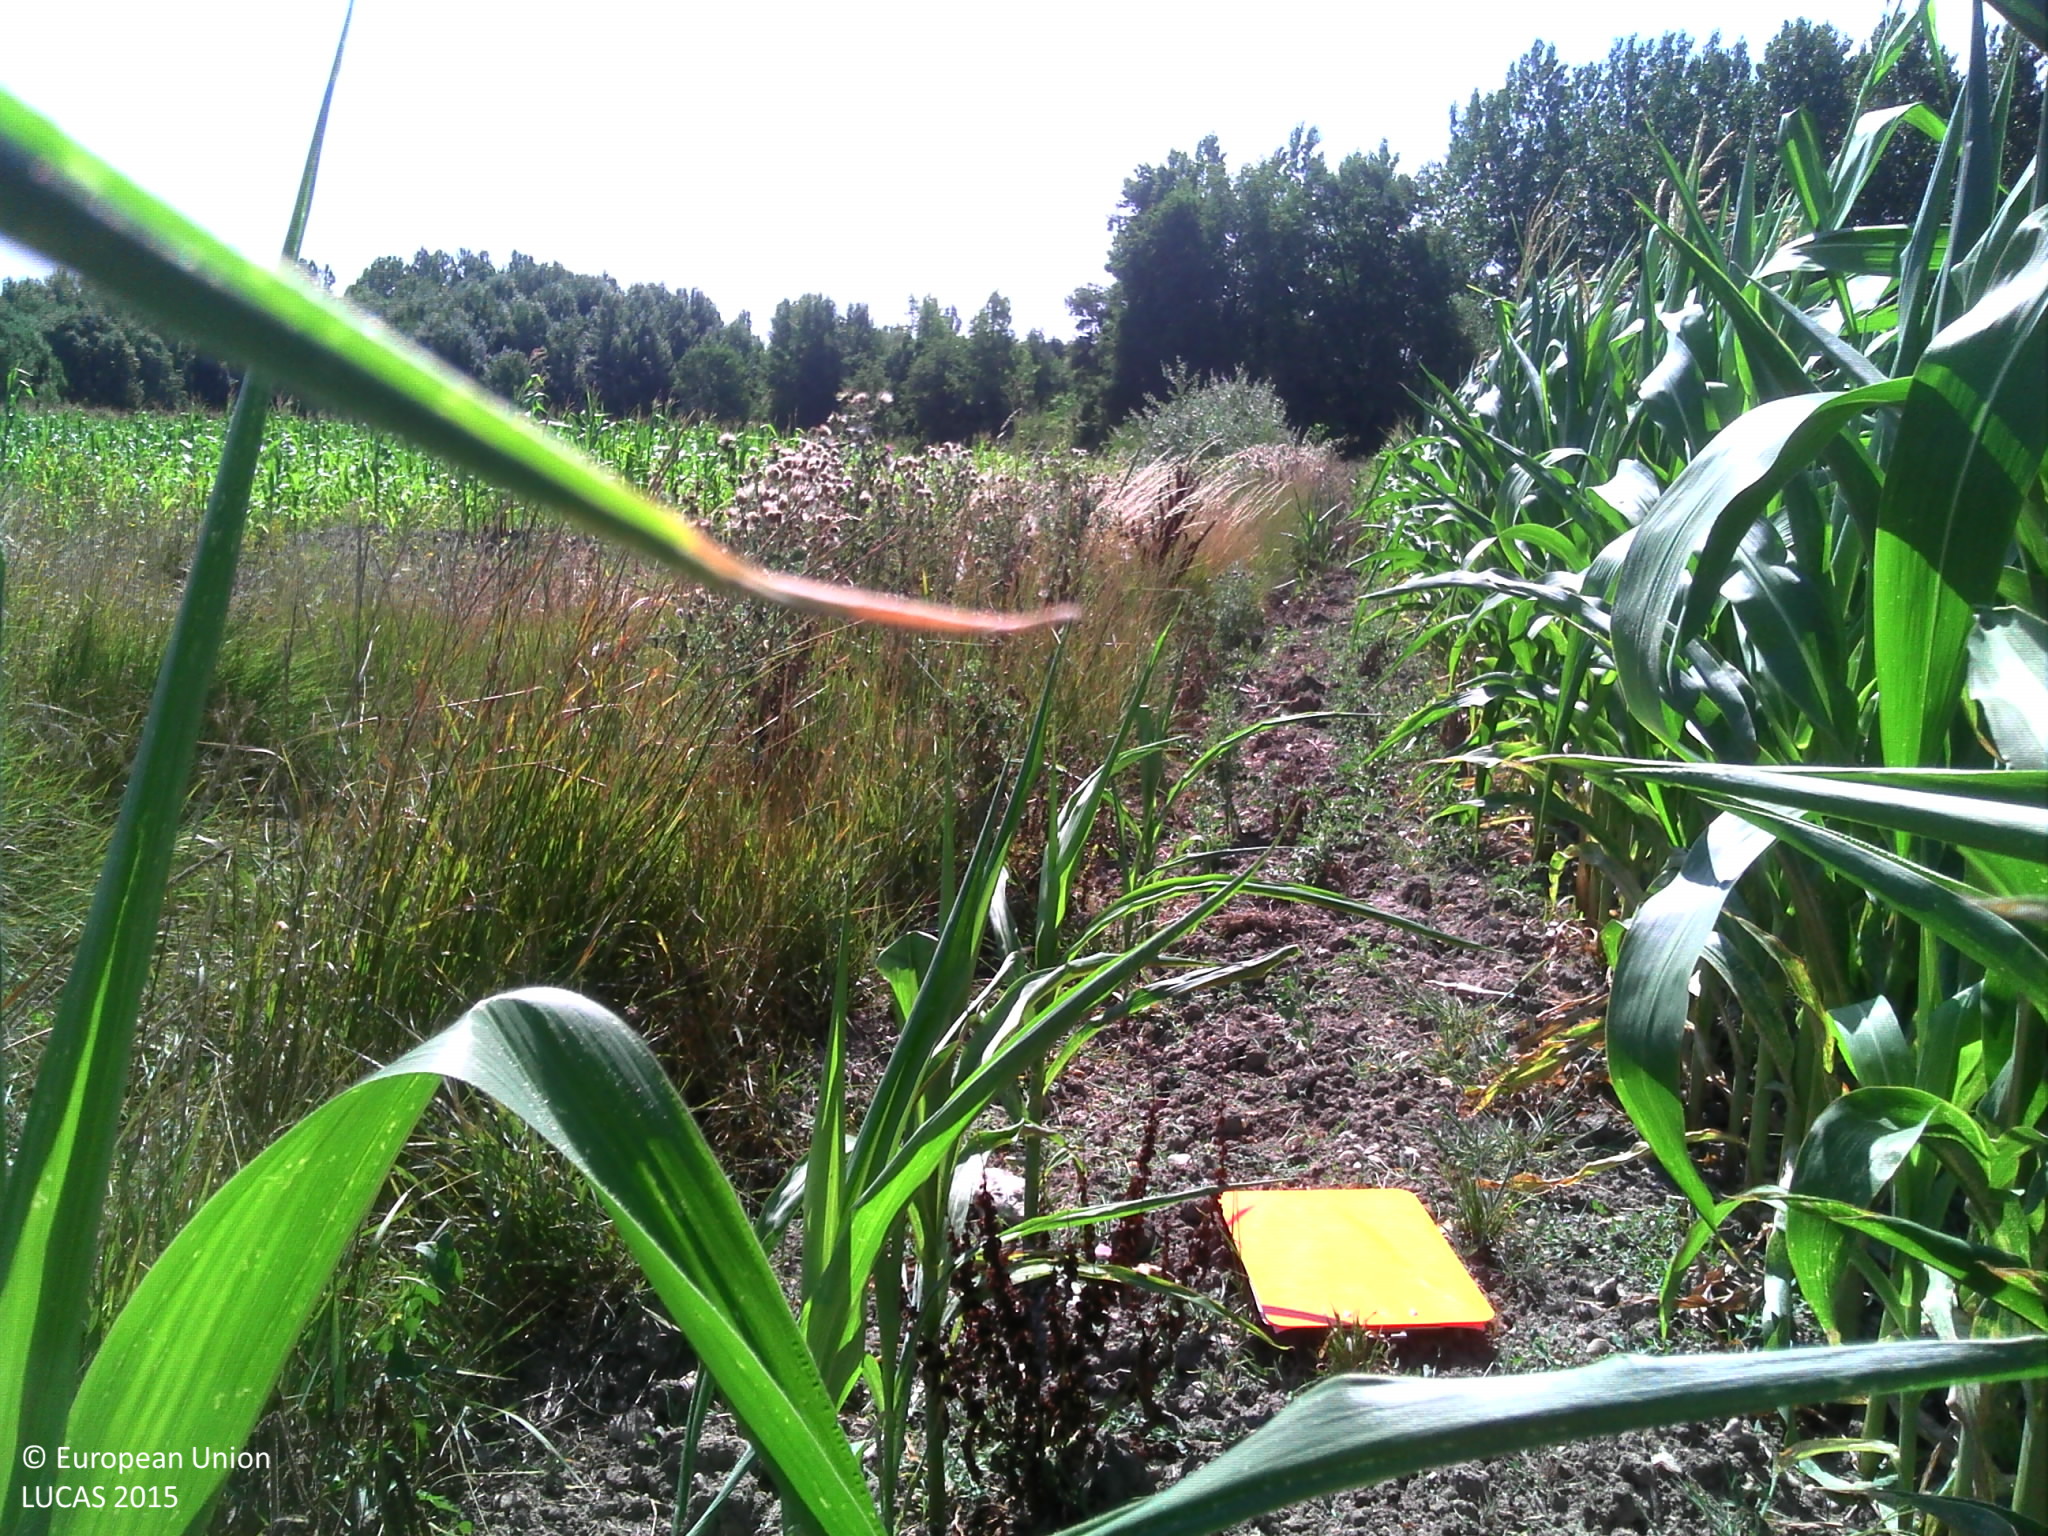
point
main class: Cropland
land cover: Maize
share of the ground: > 75 %
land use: Agriculture (excluding fallow land and kitchen gardens)
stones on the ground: < 10 %
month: July
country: FR
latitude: 47.1016
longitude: 0.4534
